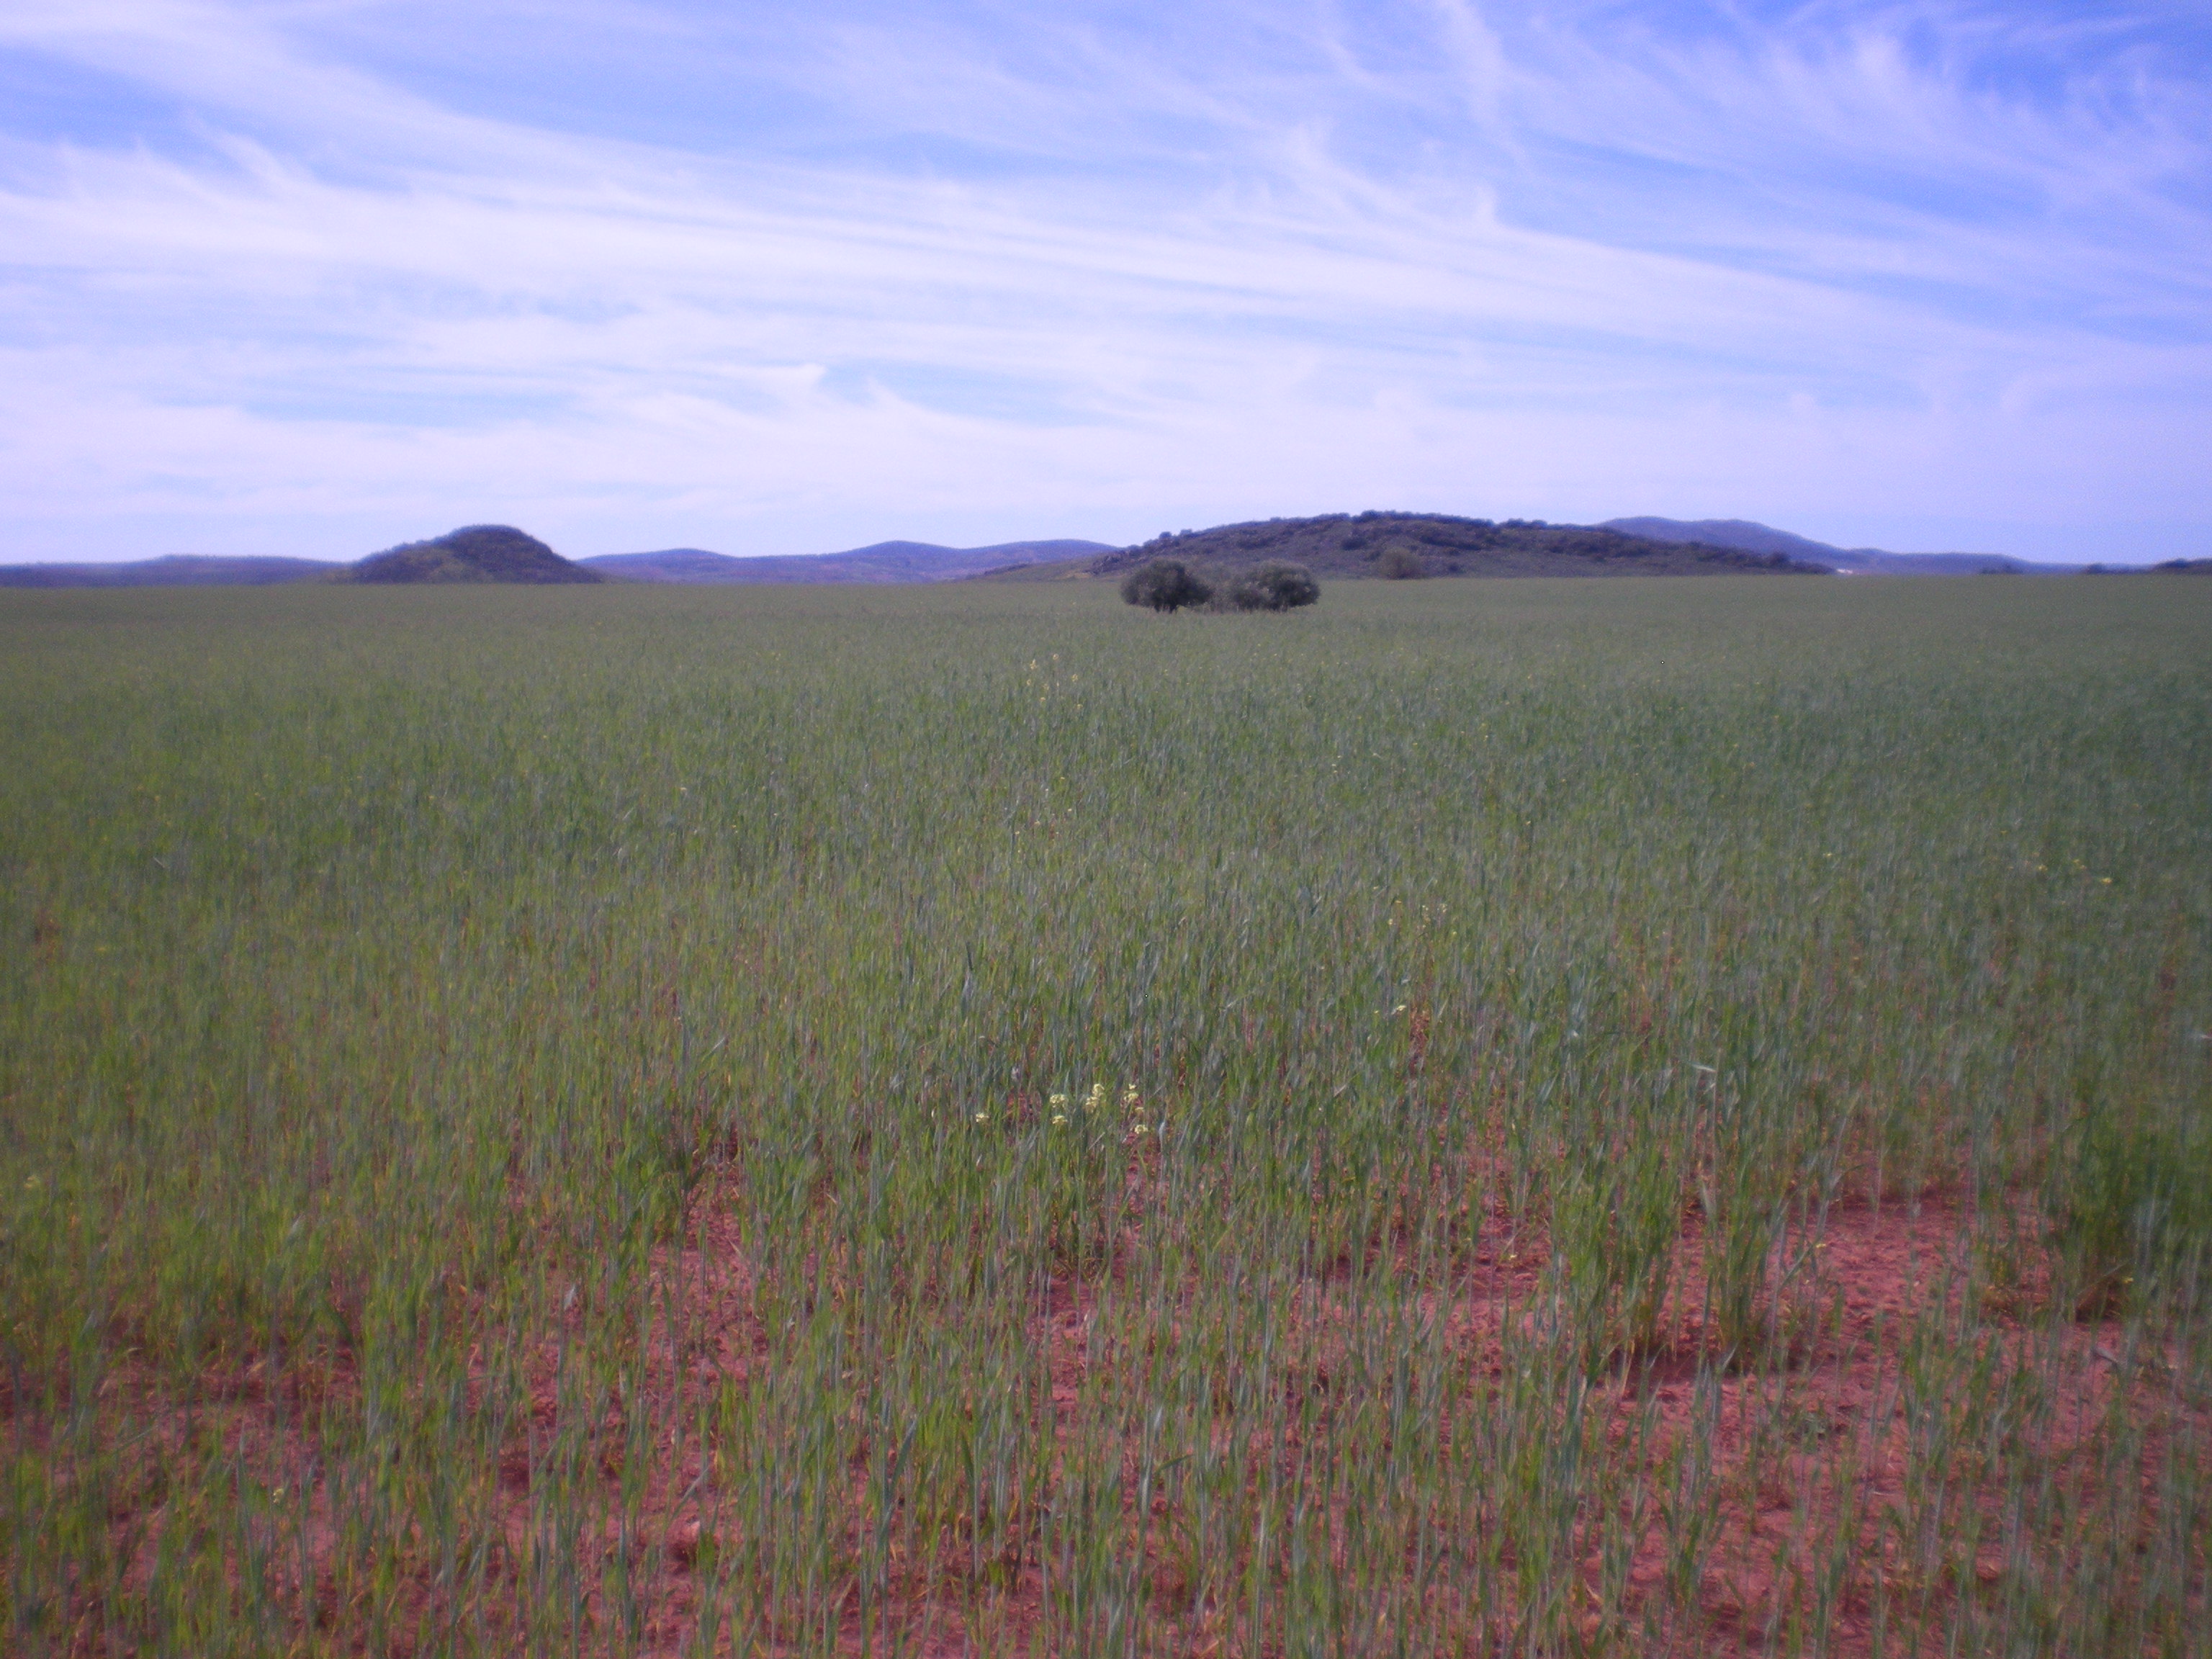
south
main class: Cropland
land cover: Durum wheat
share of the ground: 50 - 75 %
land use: Agriculture (excluding fallow land and kitchen gardens)
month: April
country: ES
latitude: 38.6150
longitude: -2.9710
